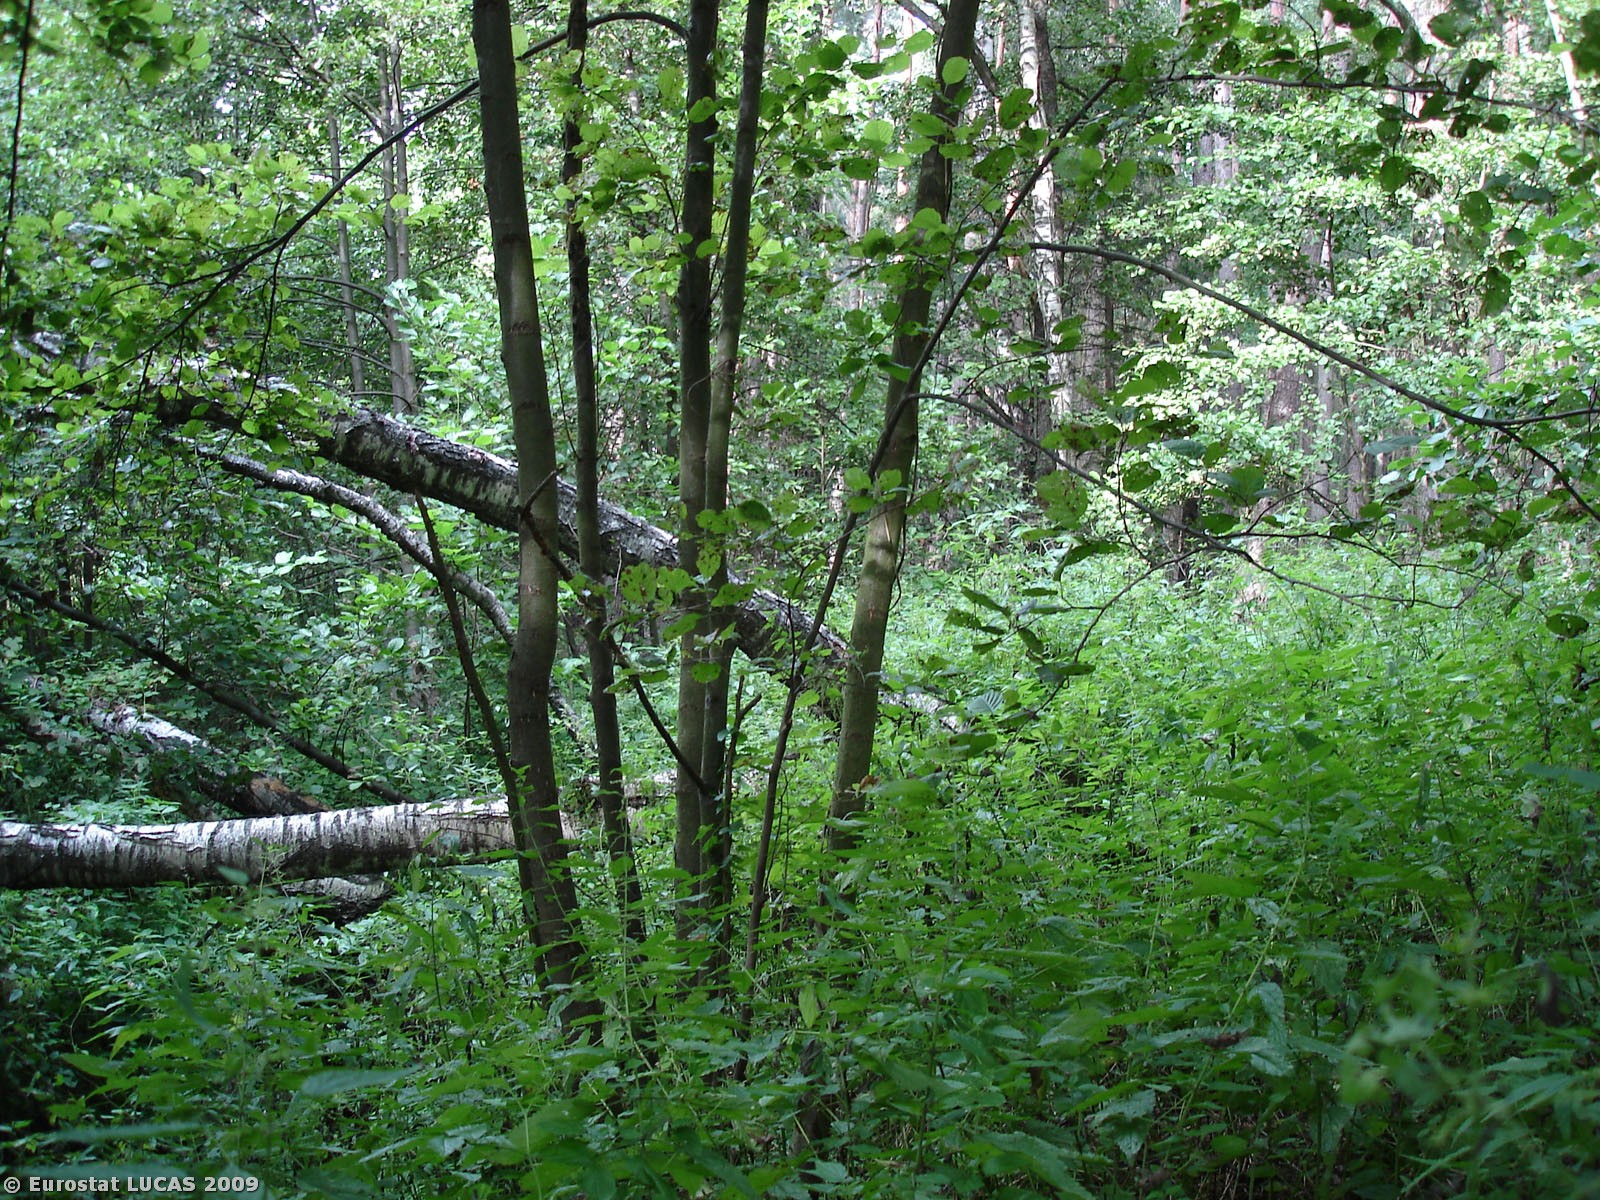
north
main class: Woodland
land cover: Broadleaved woodland
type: mesophytic deciduous forest
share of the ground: > 75 %
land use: Forestry
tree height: > 5 m
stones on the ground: < 10 %
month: August
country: PL
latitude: 50.7524
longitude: 18.2527
